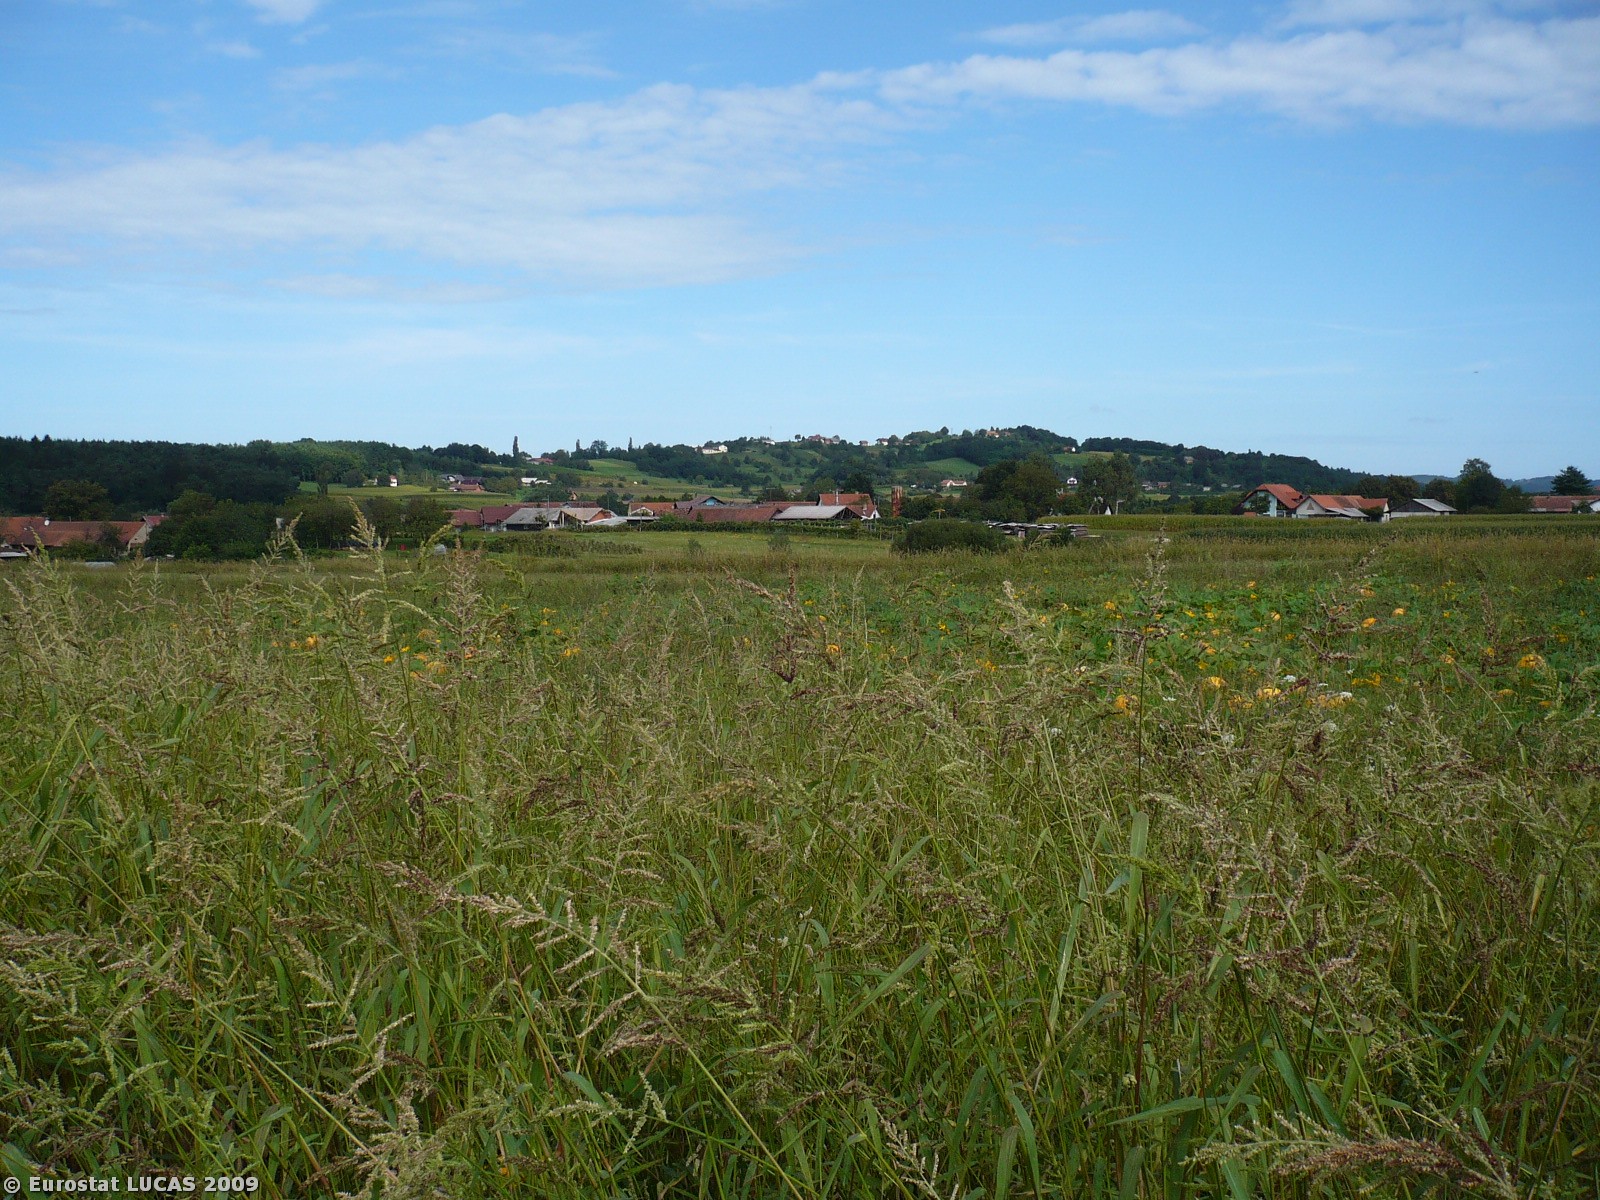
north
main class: Cropland
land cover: Other fresh vegetables
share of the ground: > 75 %
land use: Agriculture (excluding fallow land and kitchen gardens)
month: July
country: SI
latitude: 46.7751
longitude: 16.0642
